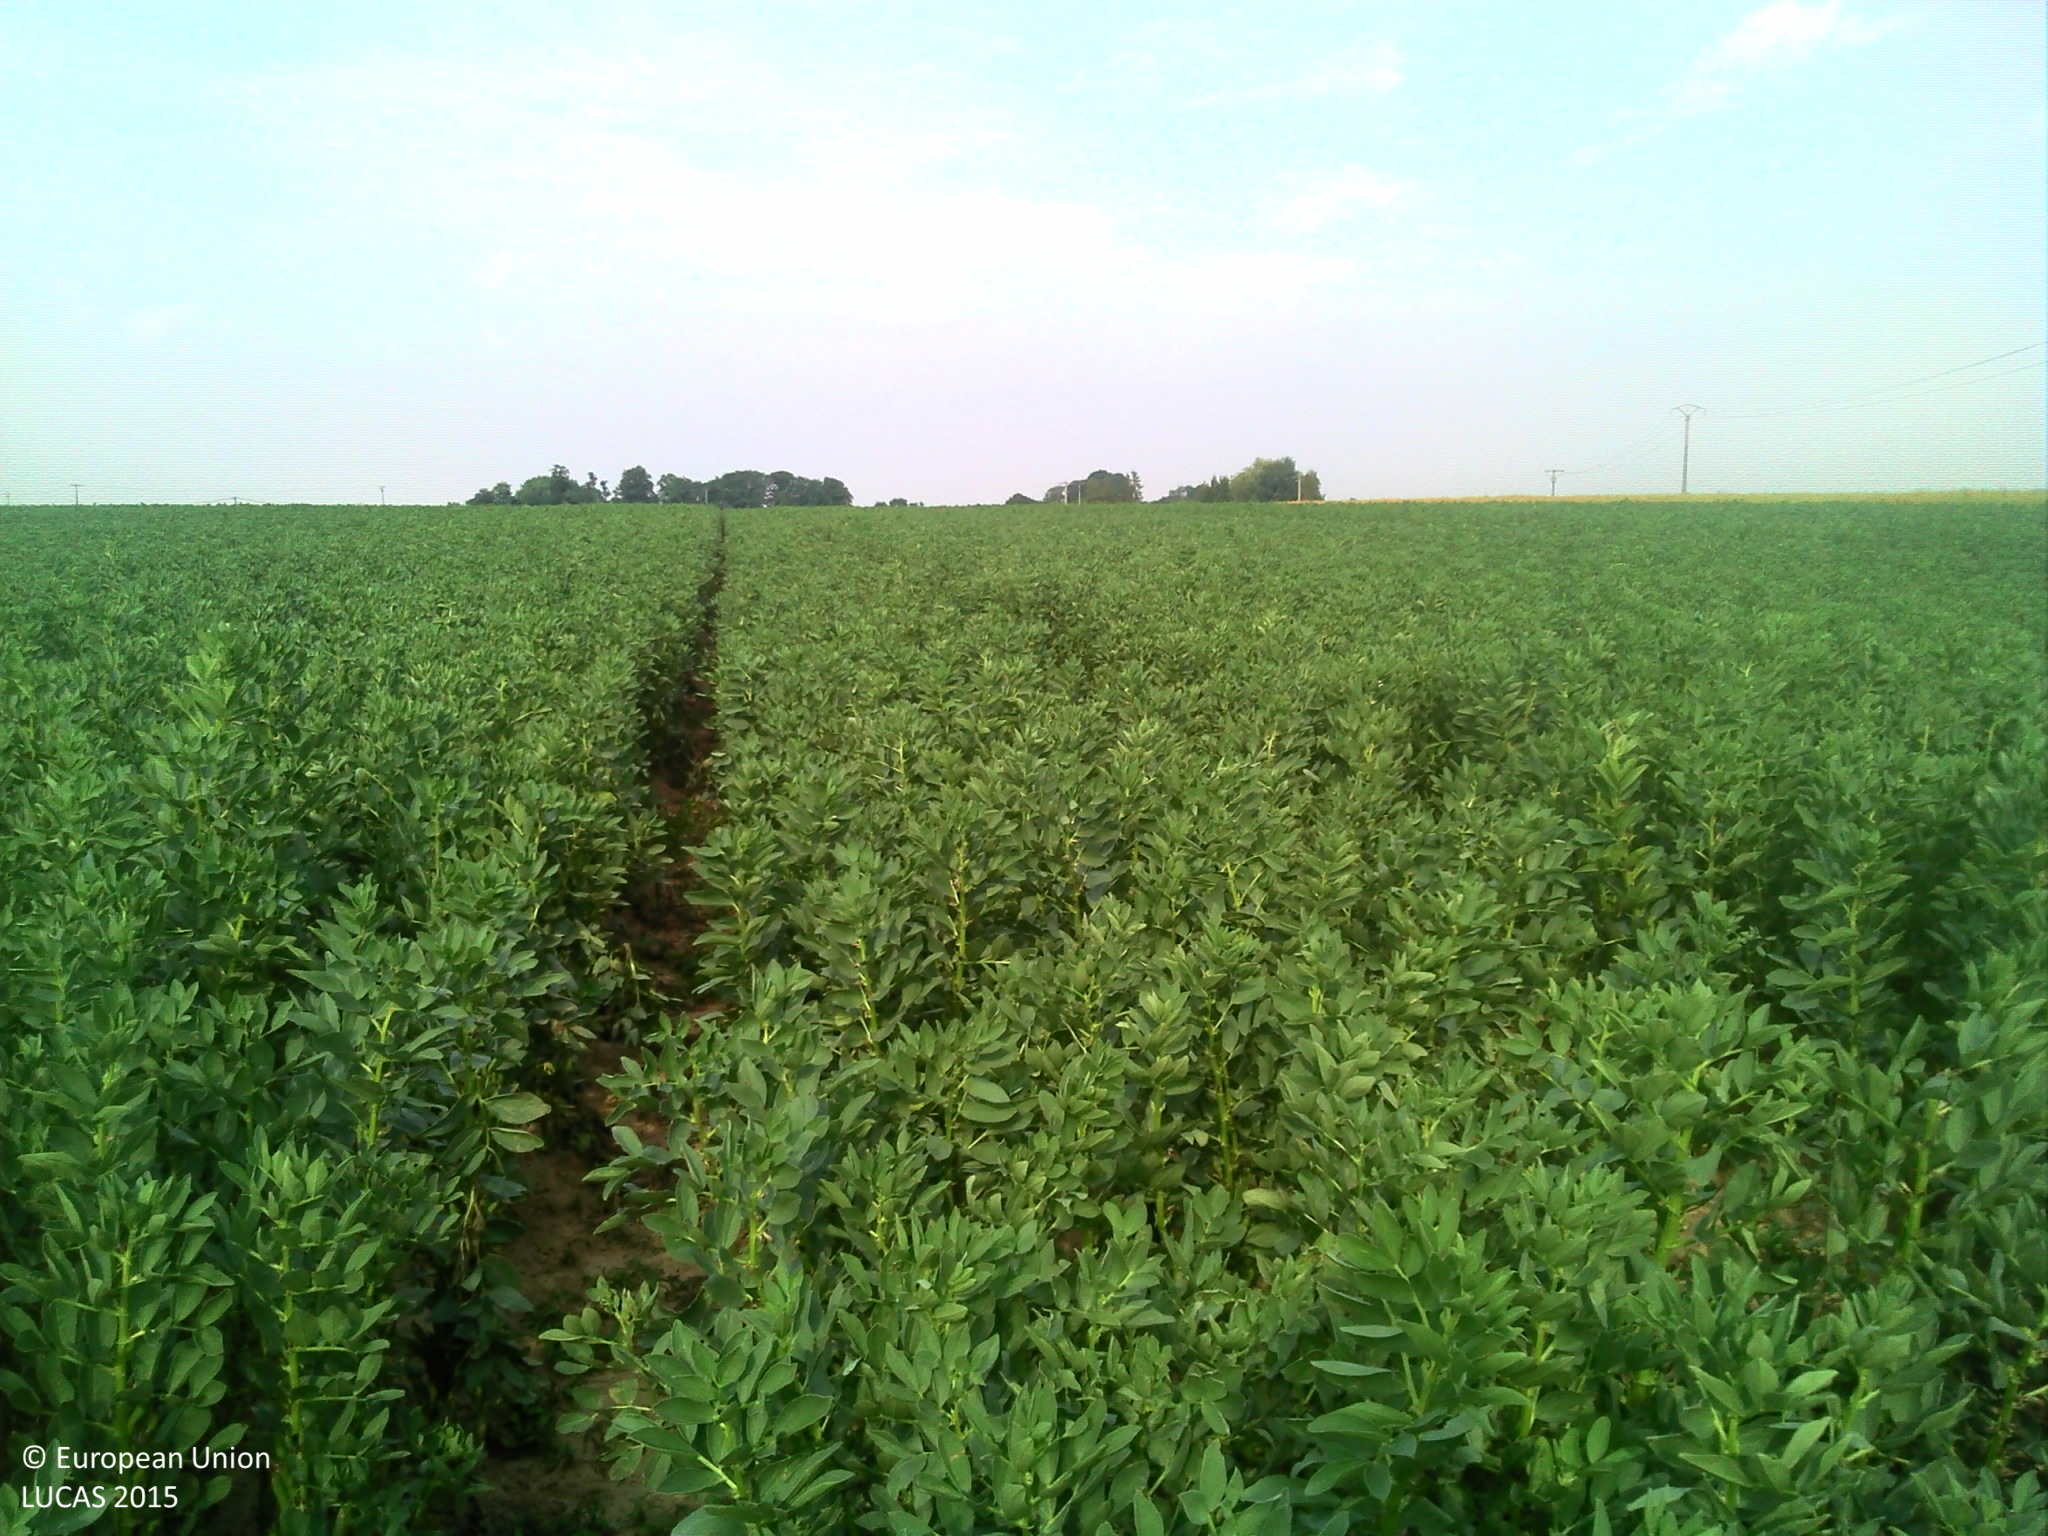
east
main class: Cropland
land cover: Dry pulses
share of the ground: > 75 %
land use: Agriculture (excluding fallow land and kitchen gardens)
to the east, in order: Dry pulses; Rape and turnip rape
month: July
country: FR
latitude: 49.3983
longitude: 0.6183
